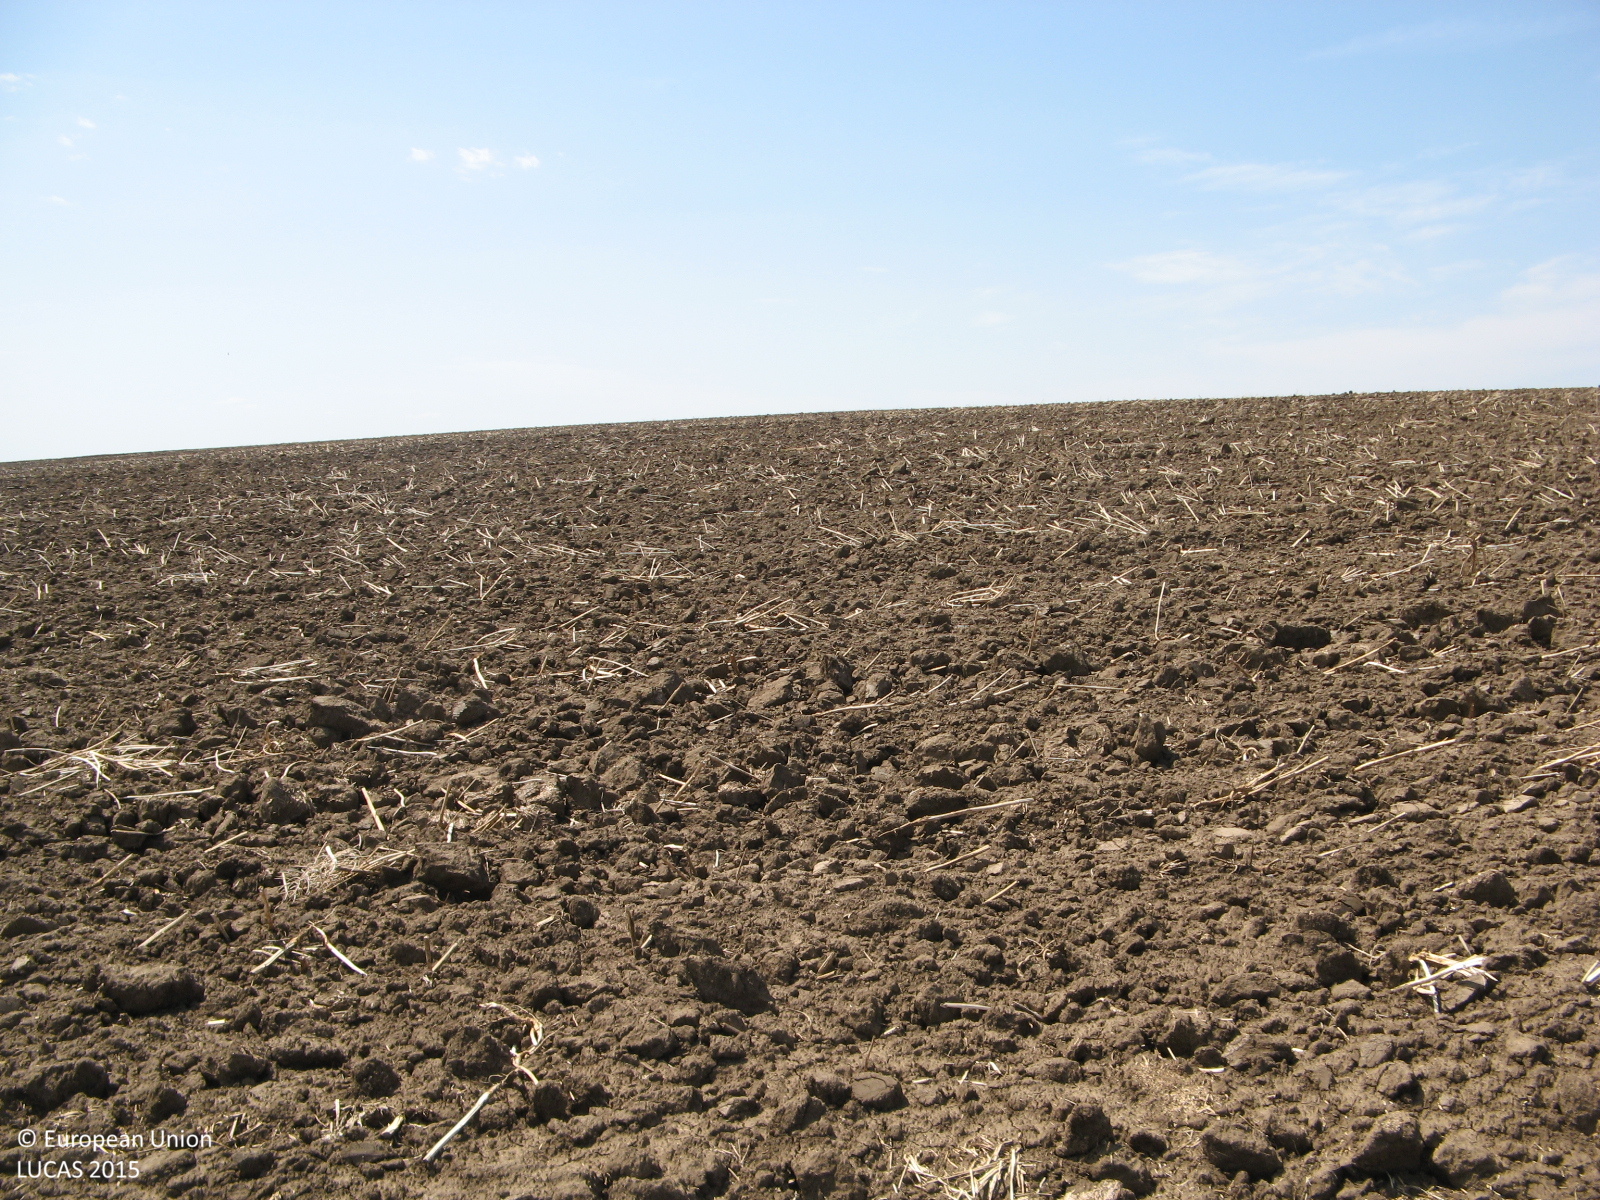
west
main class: Cropland
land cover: Rape and turnip rape
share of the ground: < 10 %
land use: Agriculture (excluding fallow land and kitchen gardens)
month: August
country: BG
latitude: 43.4797
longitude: 25.3215
